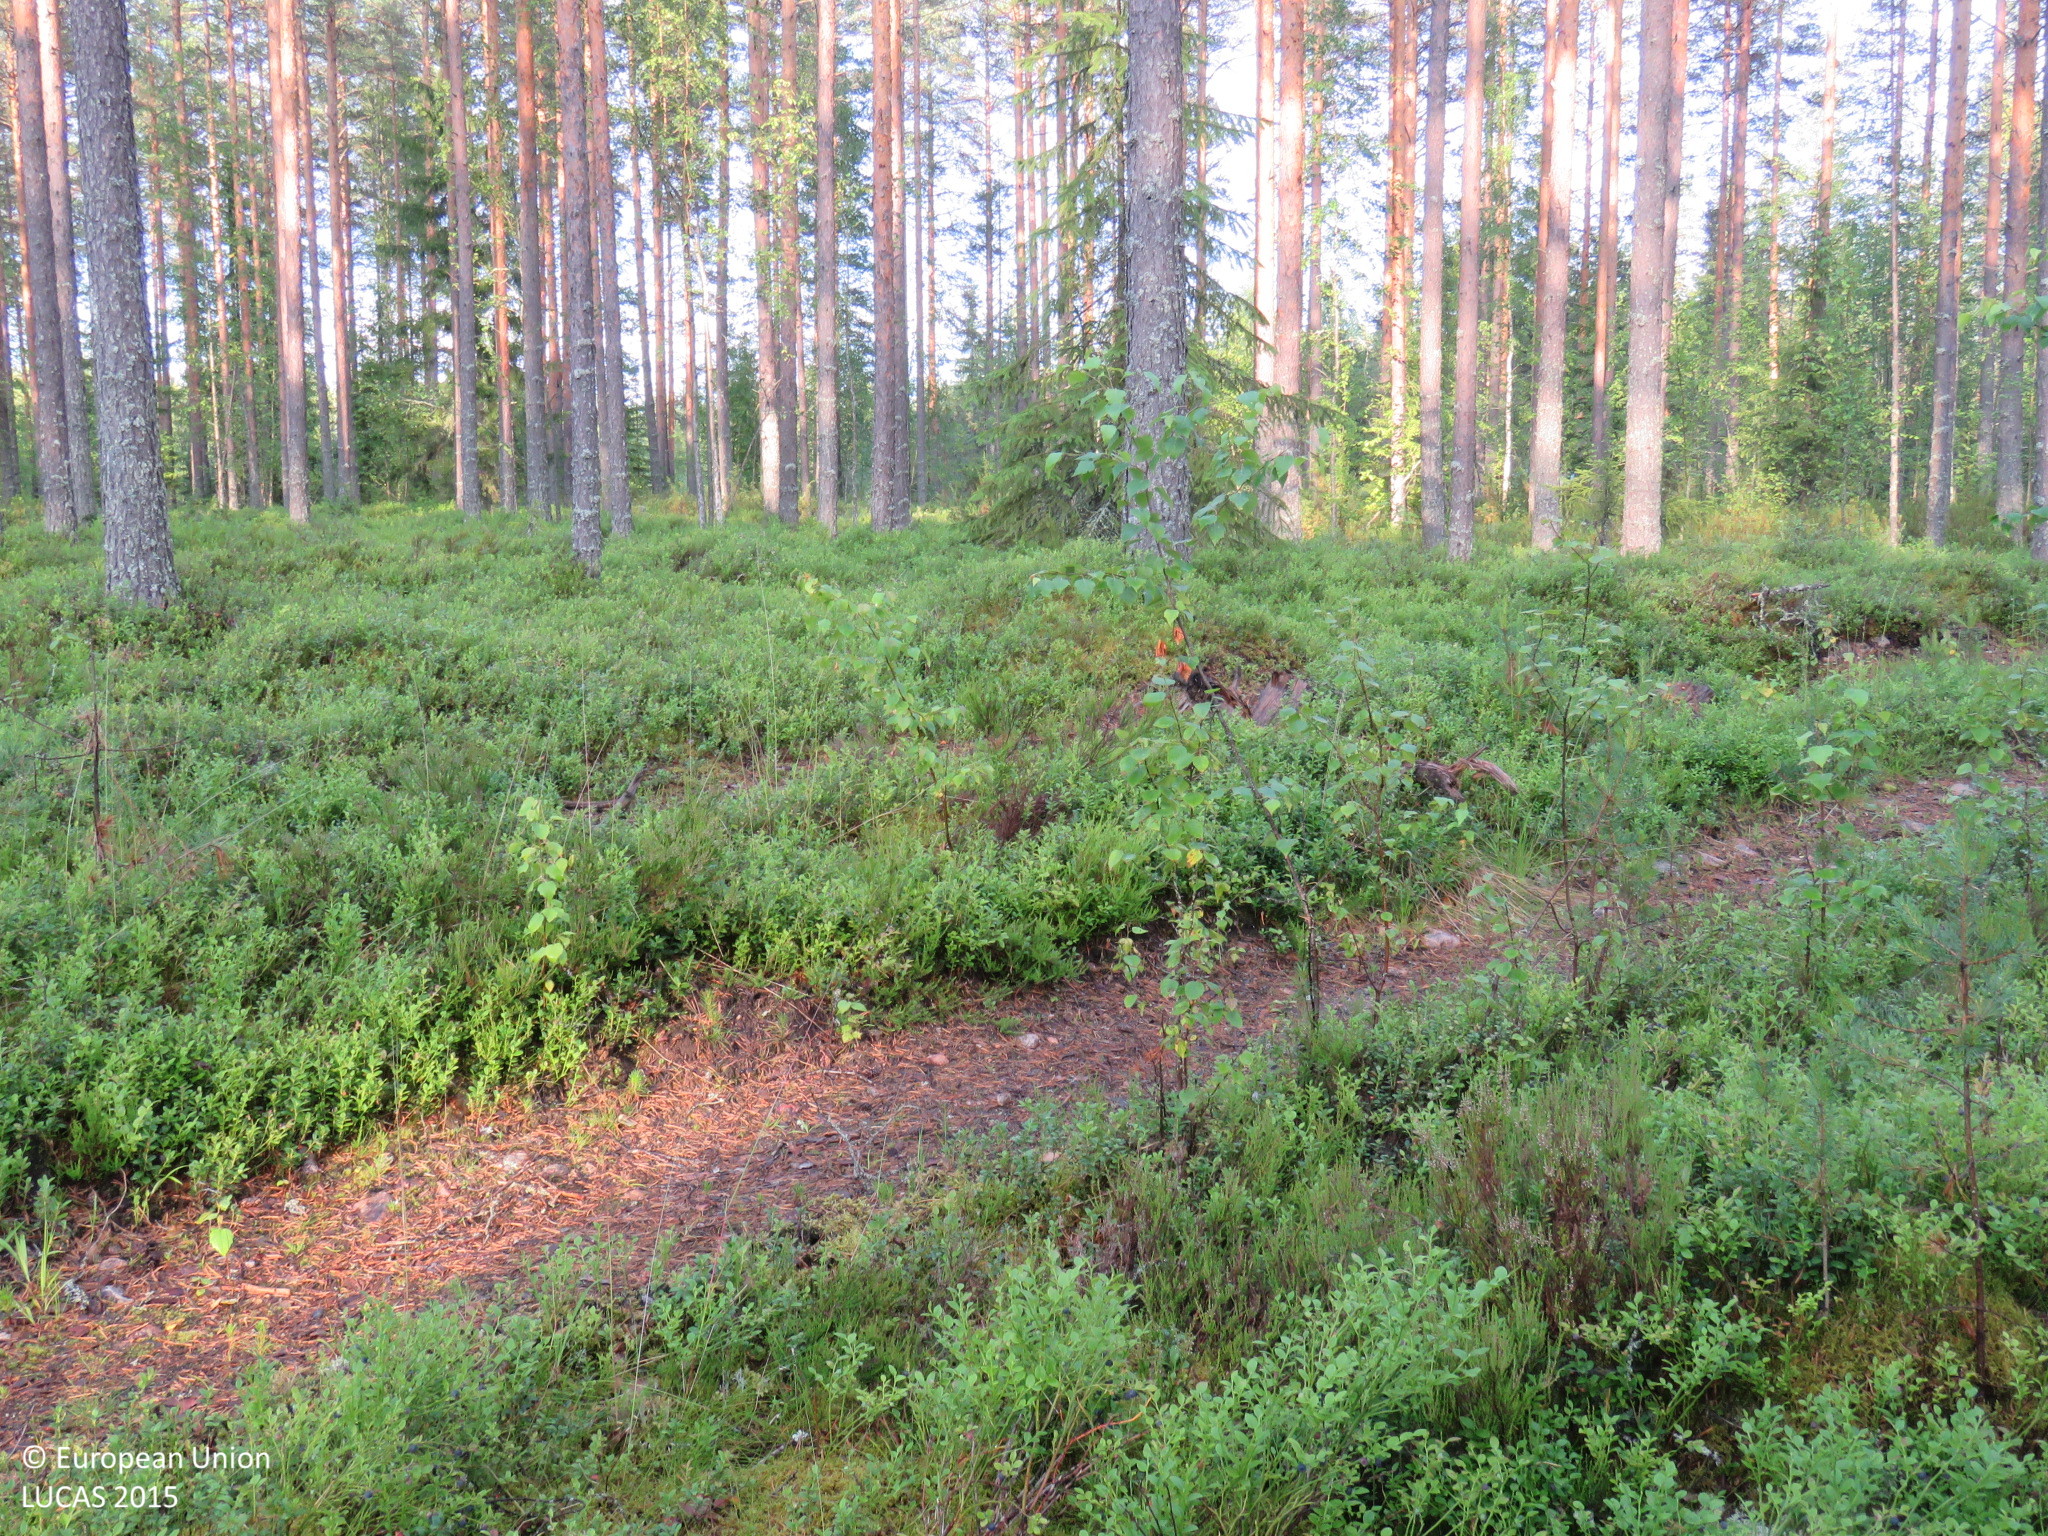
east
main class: Woodland
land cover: Pine dominated coniferous woodland
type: boreal forest
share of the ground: > 75 %
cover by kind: coniferous forest trees 65 %, broadleaved forest trees 15 %, shrubs 15 %, lichens and mosses 5 %
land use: Forestry
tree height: > 5 m
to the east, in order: Pine dominated coniferous woodland; Tracks; Pine dominated coniferous woodland; Ditches and canals; Grass margins; Paved roads, cycling and walking lanes; Grass margins; Ditches and canals; Shrubland with sparse tree cover; Pine dominated mixed woodland; Pine dominated coniferous woodland; Spruce dominated coniferous woodland; Other mixed woodland; Electric lines; Shrubland with sparse tree cover; Spruce dominated mixed woodland; Groves; Ditches and canals; Temporary grasslands
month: July
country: FI
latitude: 64.1676
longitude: 26.3858
